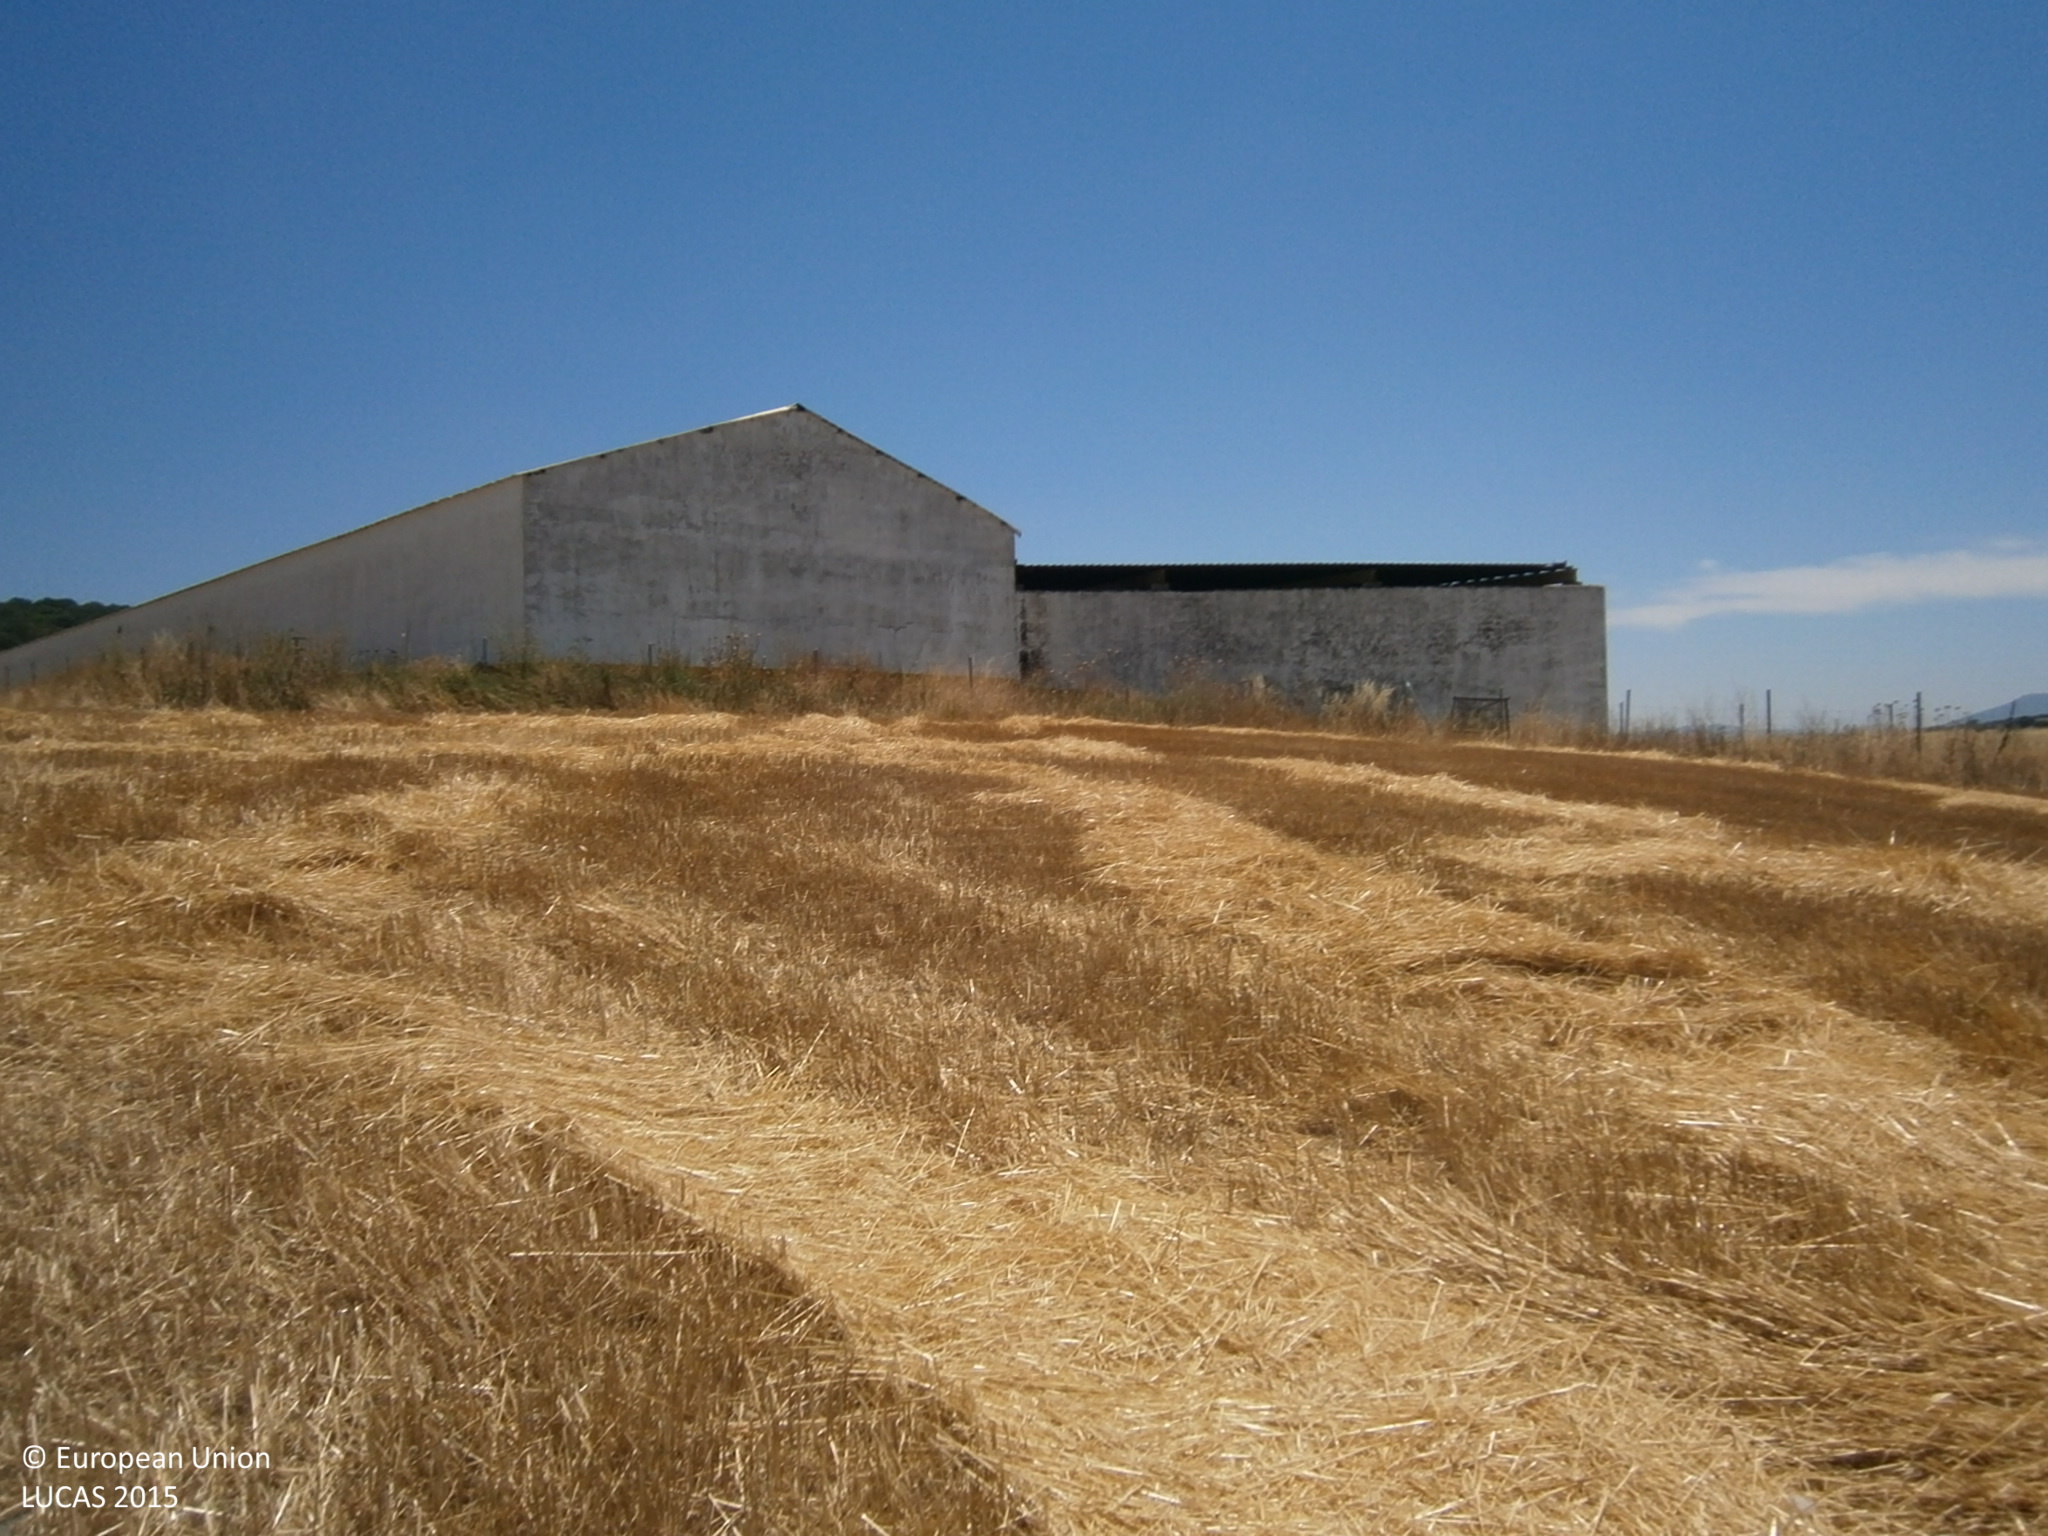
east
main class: Cropland
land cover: Oats
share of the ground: > 75 %
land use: Agriculture (excluding fallow land and kitchen gardens)
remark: Harvested field
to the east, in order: Oats; Fences; Other bare soil; Artificial constructions in urban areas; Fences; Tracks; Oats
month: June
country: ES
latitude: 38.6561
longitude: -6.9224
